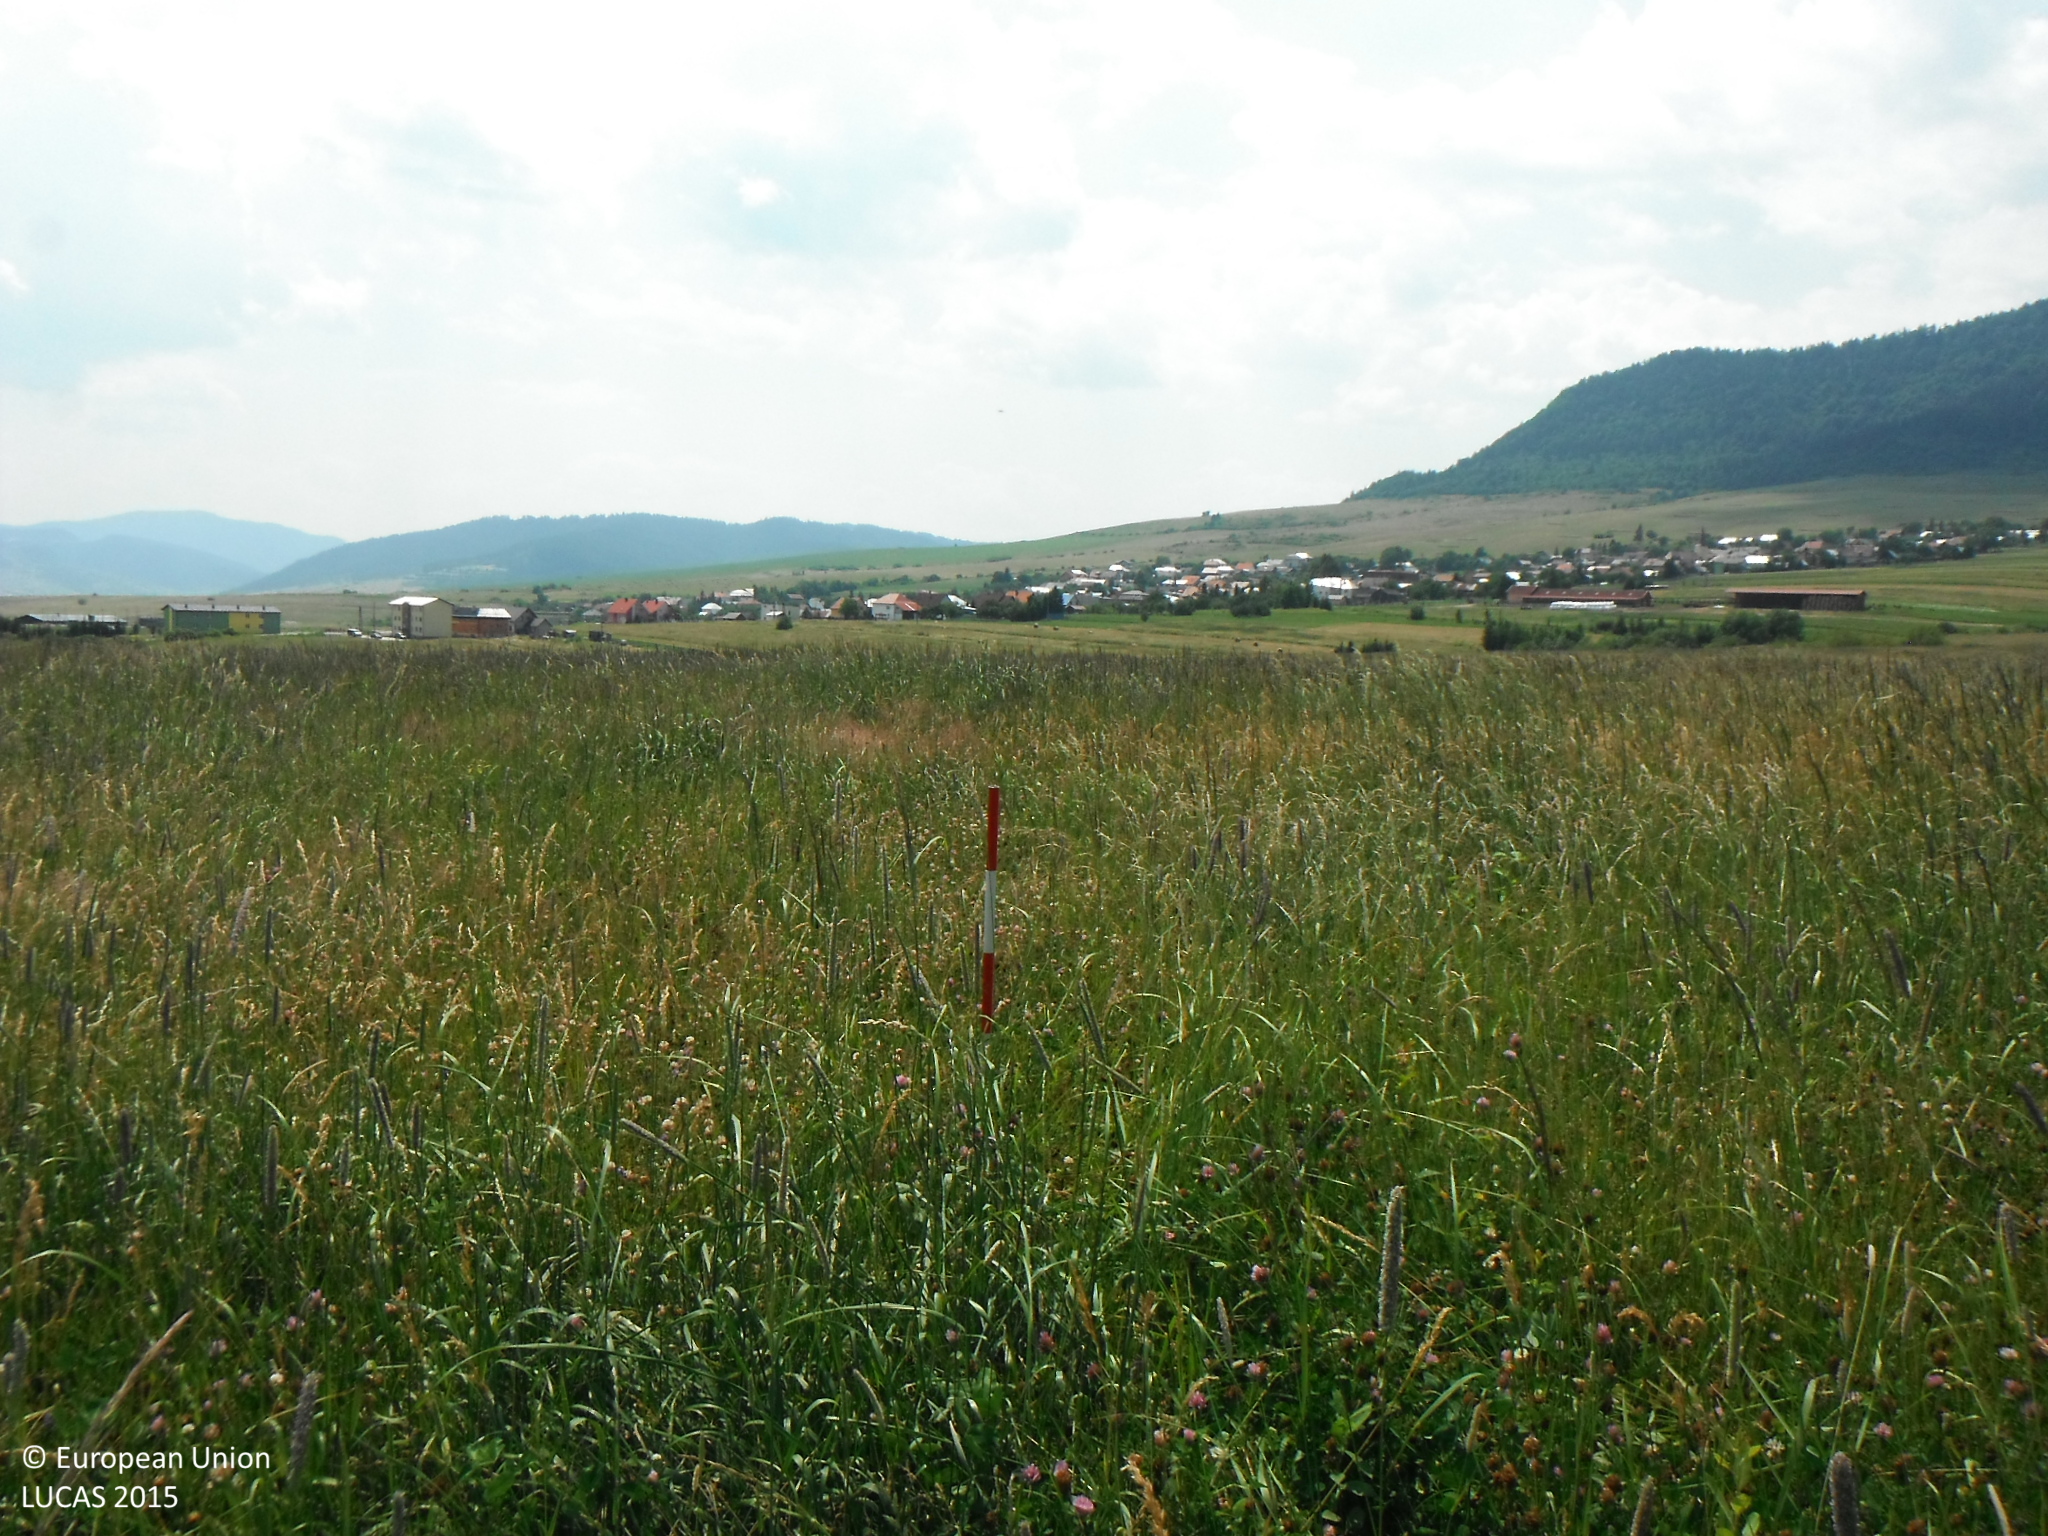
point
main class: Cropland
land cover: Temporary grasslands
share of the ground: > 75 %
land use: Agriculture (excluding fallow land and kitchen gardens)
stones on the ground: 10 - 25 %
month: July
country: SK
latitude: 49.1762
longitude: 20.8359
